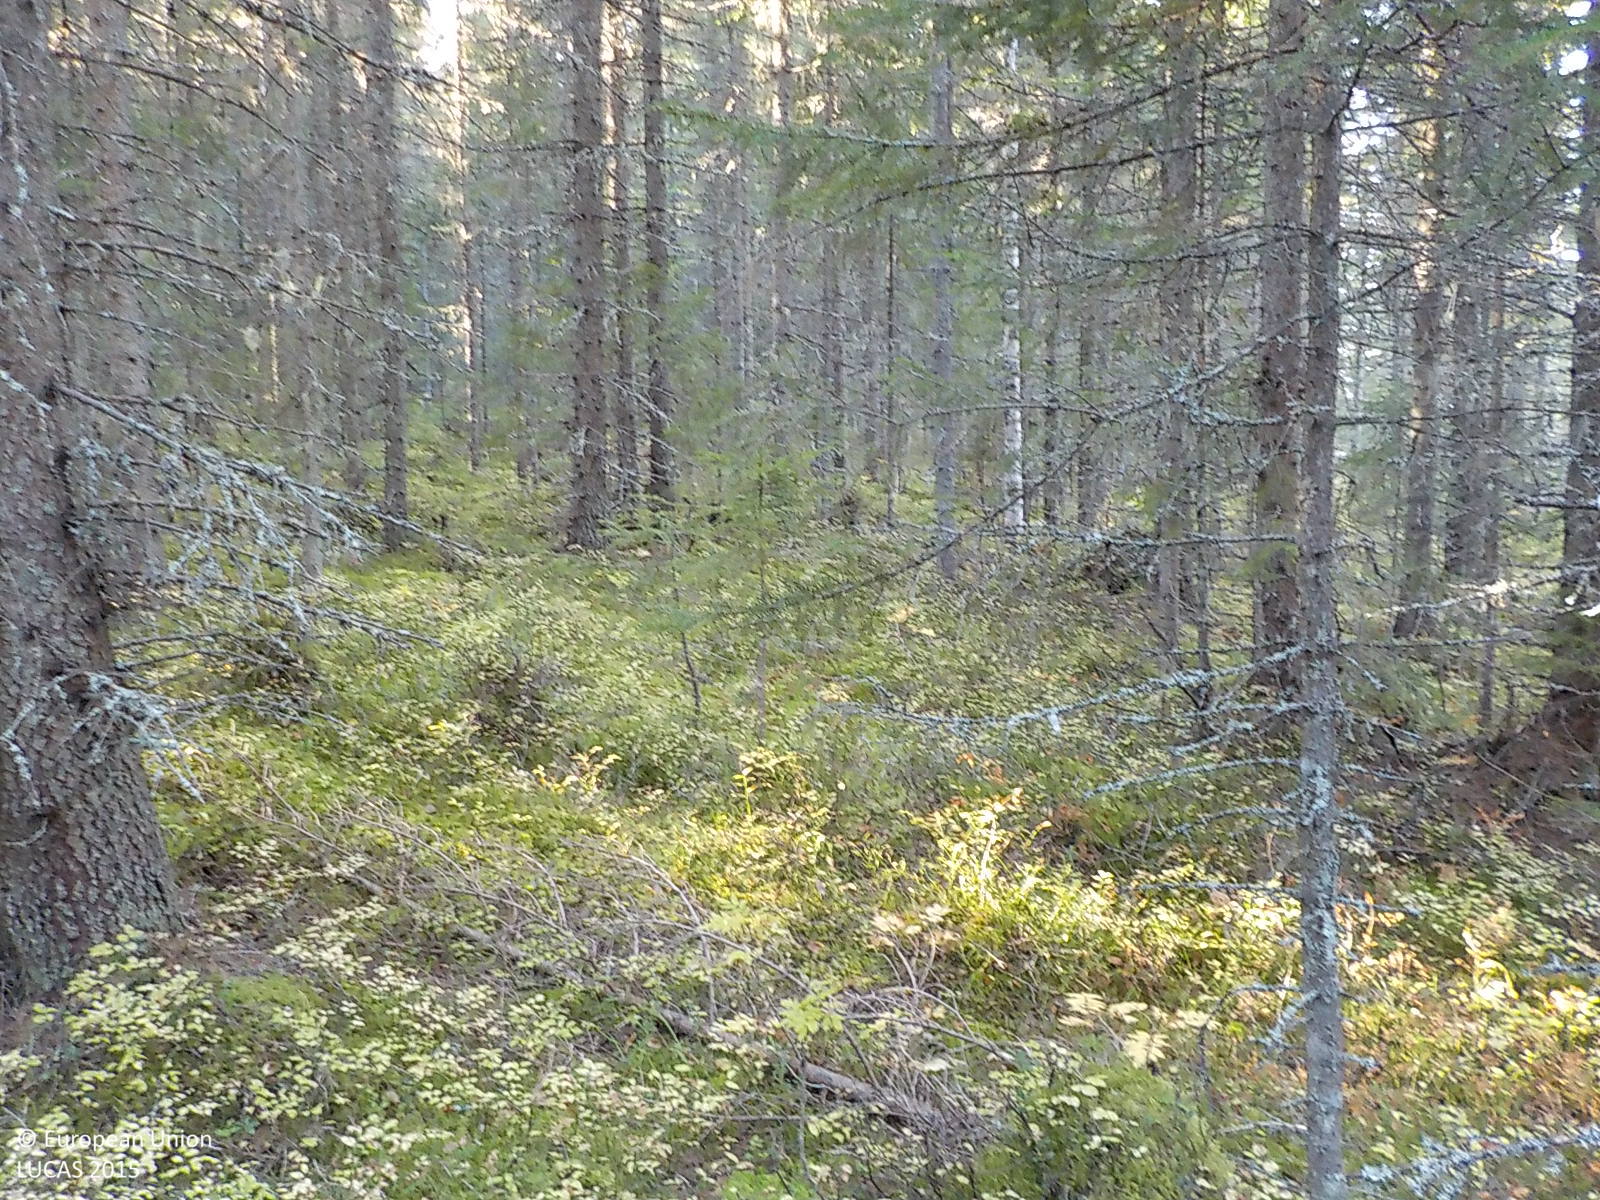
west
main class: Woodland
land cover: Spruce dominated coniferous woodland
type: boreal forest
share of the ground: > 75 %
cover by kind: coniferous forest trees 80 %, shrubs 20 %
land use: Forestry
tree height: > 5 m
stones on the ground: < 10 %
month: October
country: SE
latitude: 63.2658
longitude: 18.0860
